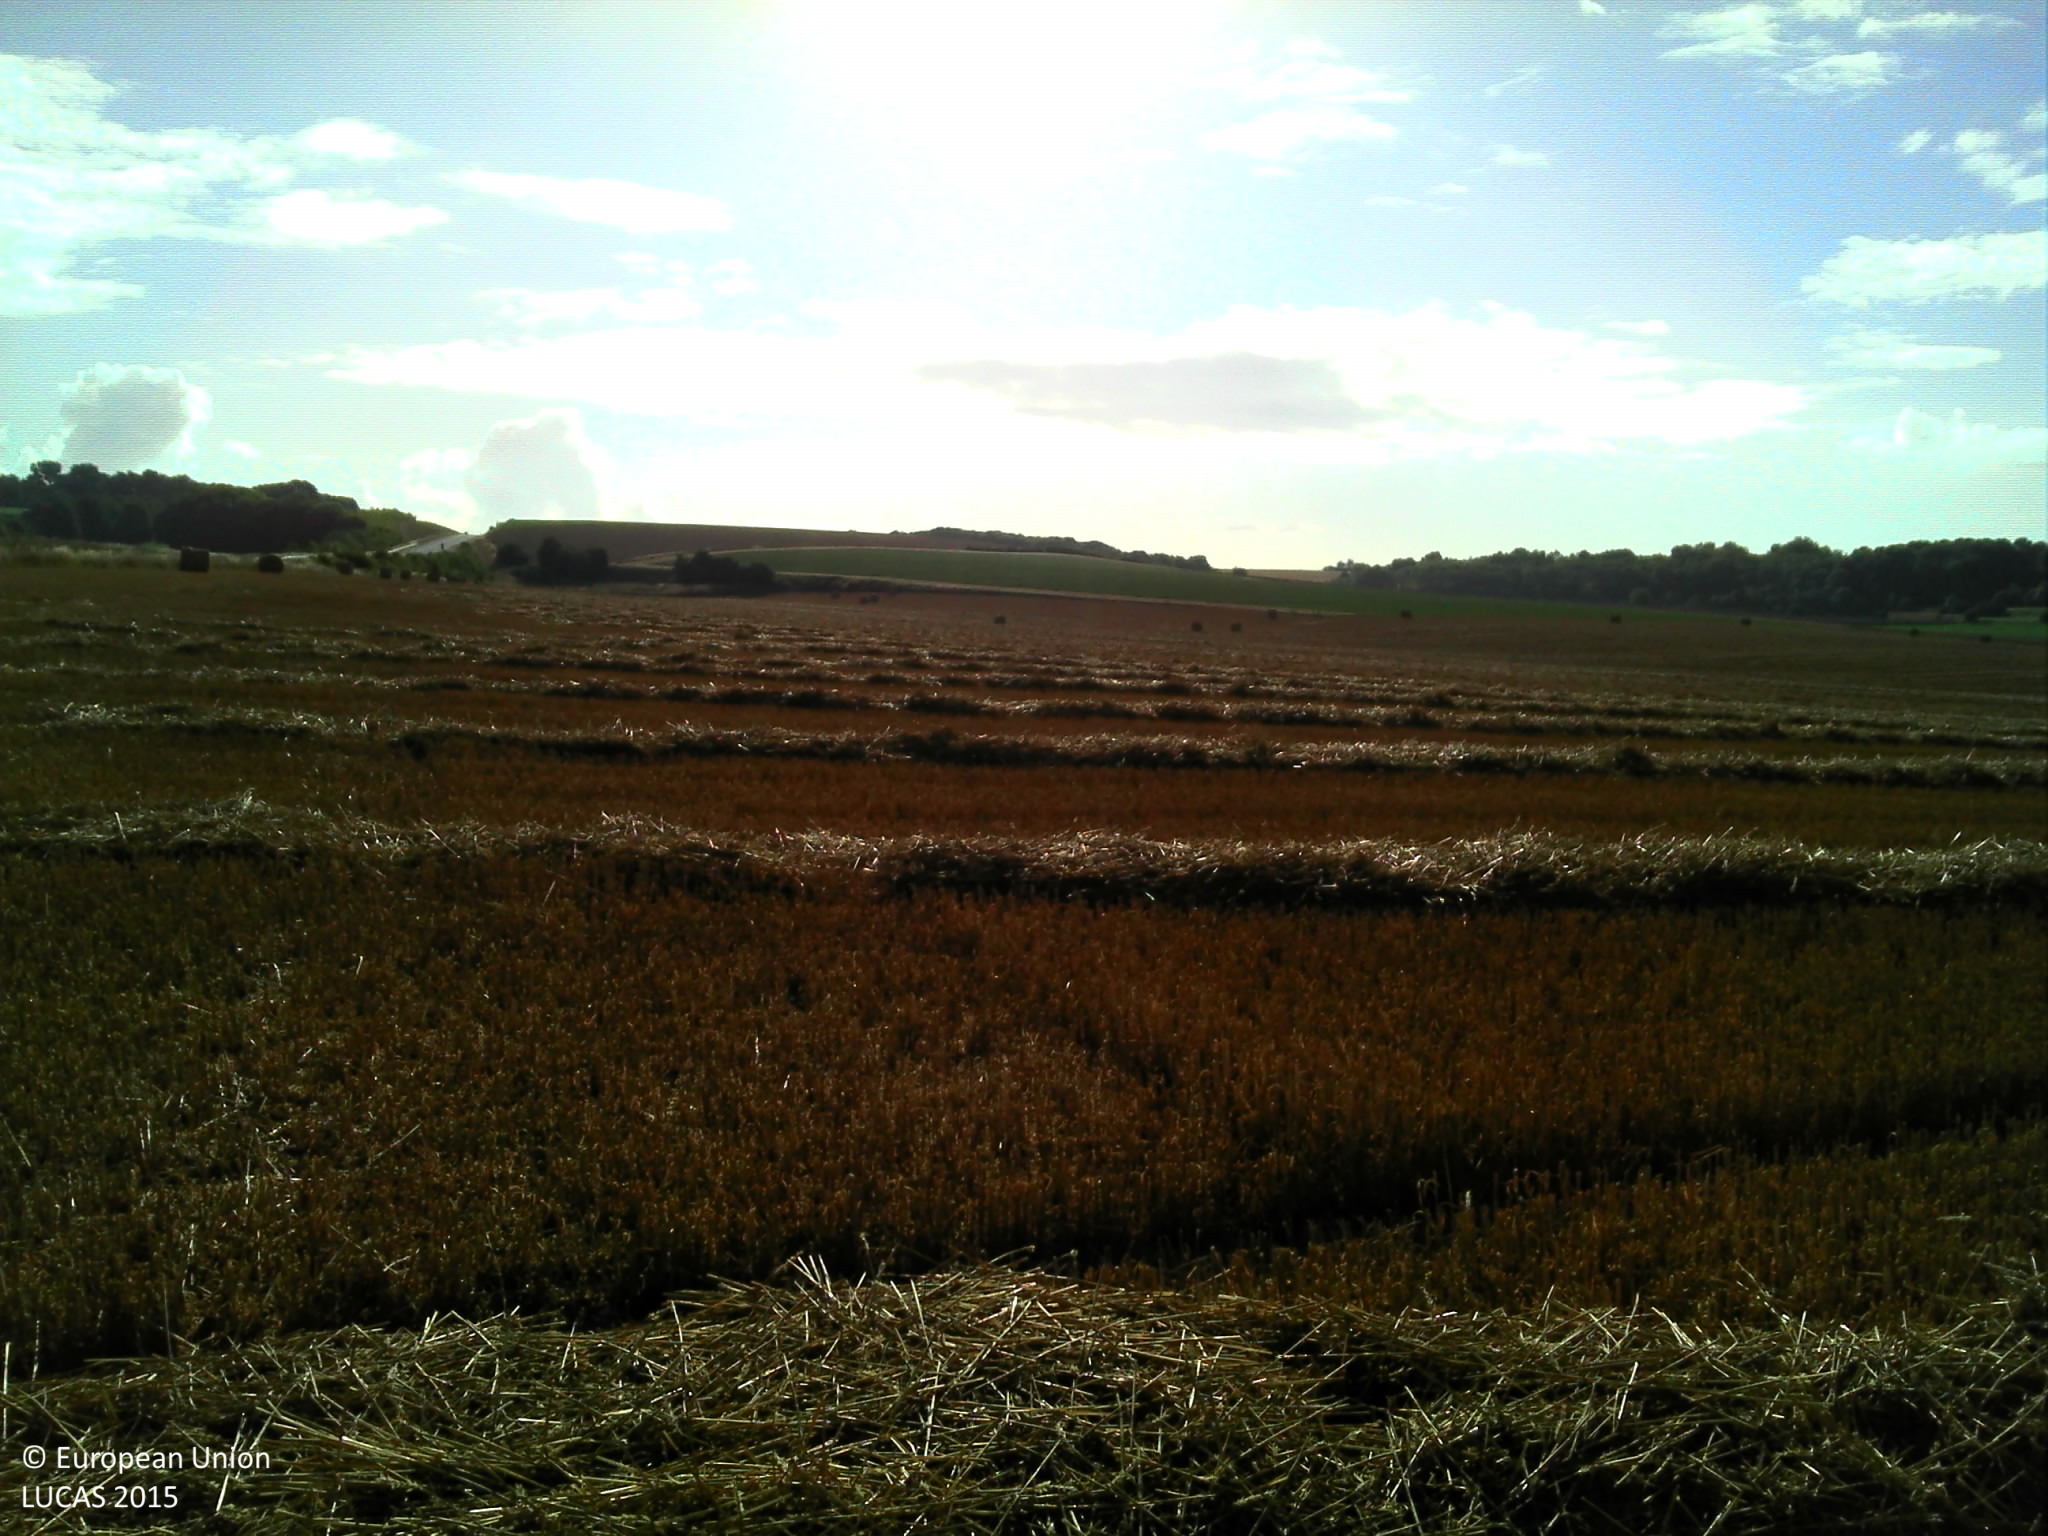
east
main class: Cropland
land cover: Common wheat
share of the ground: > 75 %
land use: Agriculture (excluding fallow land and kitchen gardens)
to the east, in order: Common wheat
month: July
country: FR
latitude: 49.9516
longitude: 2.4474
